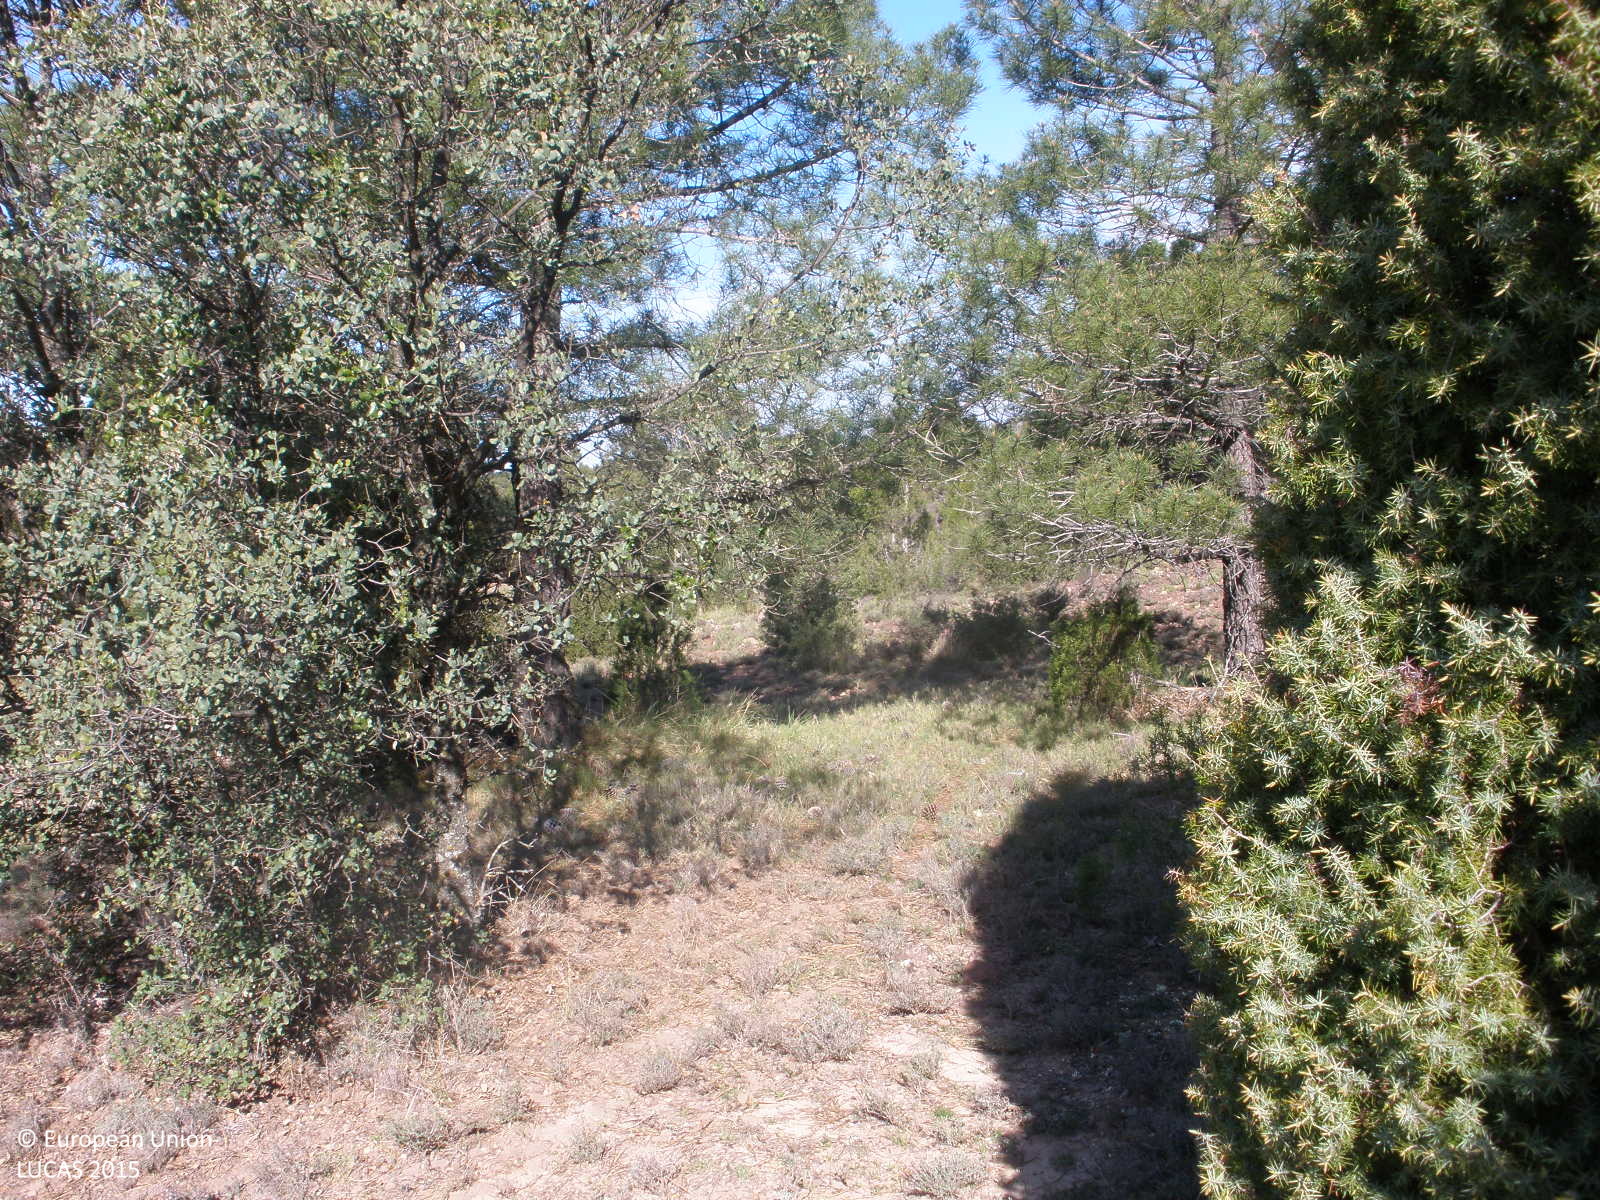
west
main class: Woodland
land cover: Other mixed woodland
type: coniferous forest of the mediterranean region
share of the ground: 50 - 75 %
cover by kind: consolidated bare surface 40 %, coniferous forest trees 30 %, broadleaved forest trees 20 %, shrubs 10 %
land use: Semi-natural and natural areas not in use
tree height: < 5 m
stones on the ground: 25 - 50 %
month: April
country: ES
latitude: 40.2951
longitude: -0.7484
